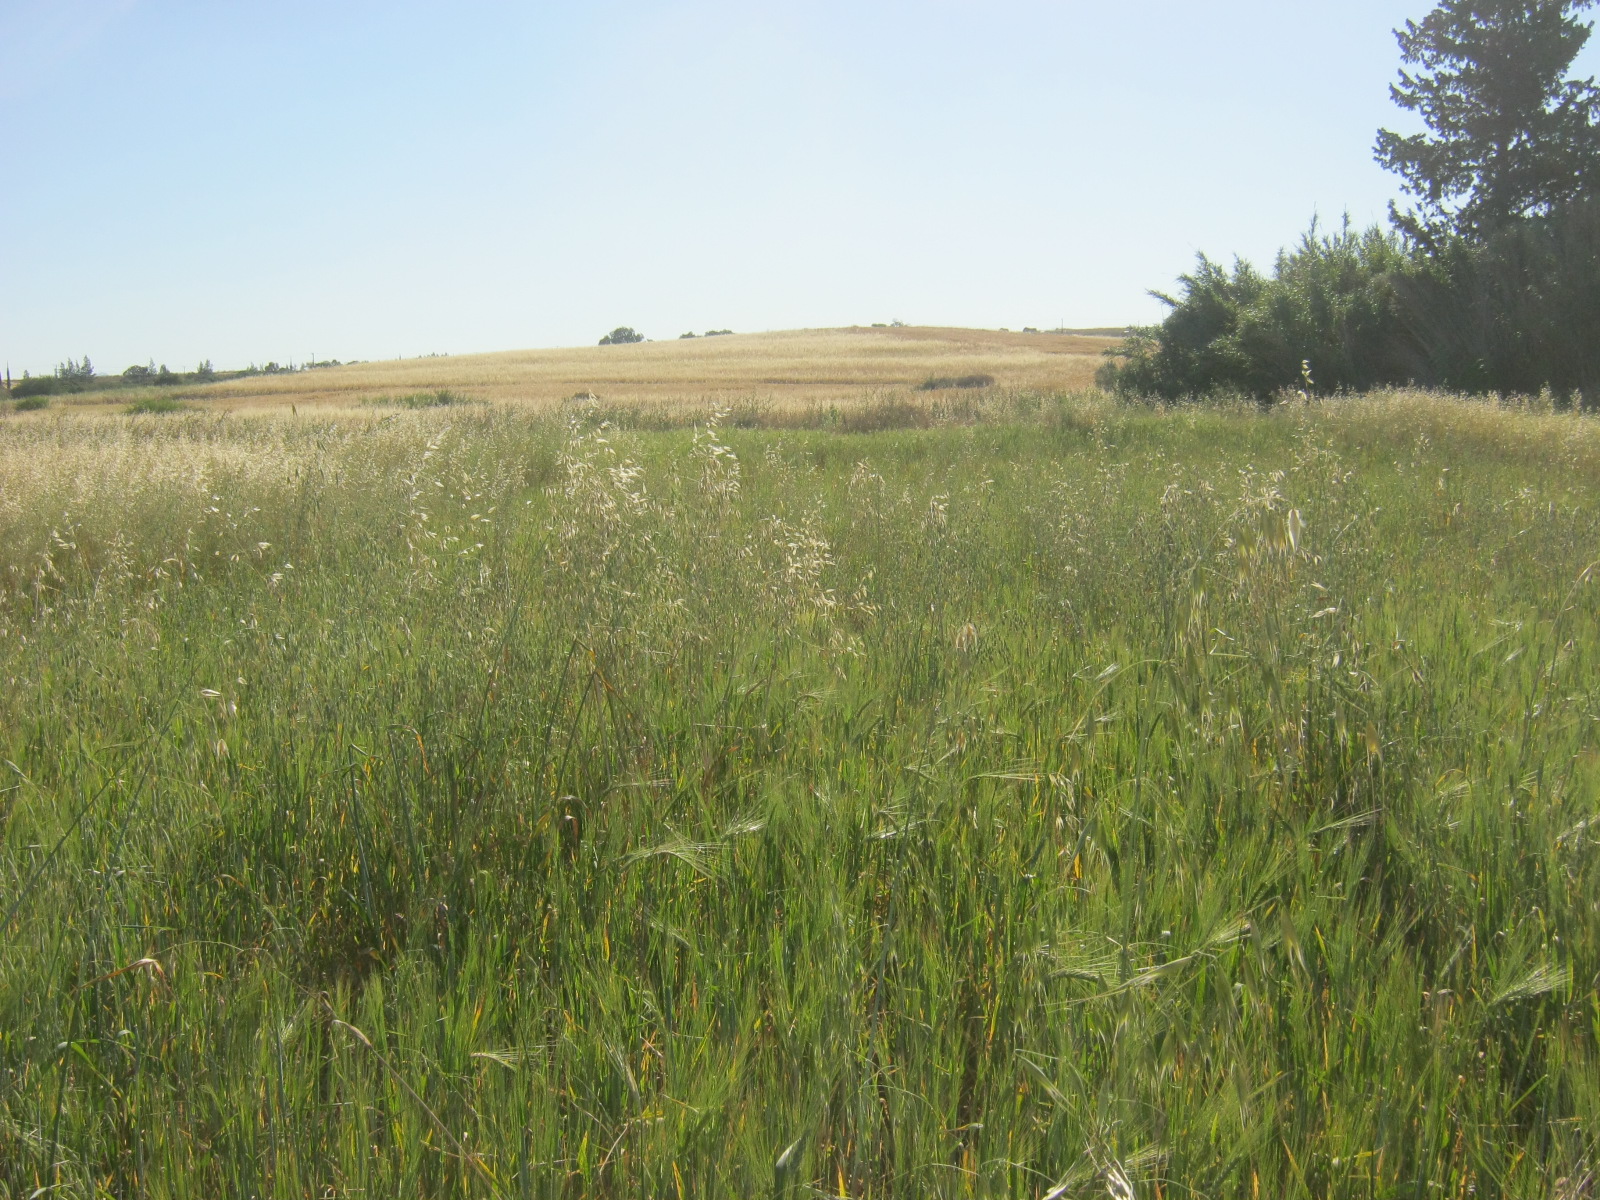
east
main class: Cropland
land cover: Common wheat
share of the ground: > 75 %
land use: Agriculture (excluding fallow land and kitchen gardens)
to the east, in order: Common wheat; Tracks; Grassland without tree/shrub cover; Rivers and streams; Grassland without tree/shrub cover; Common wheat; Olive groves; Common wheat
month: May
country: CY
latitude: 35.1428
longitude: 33.2488
